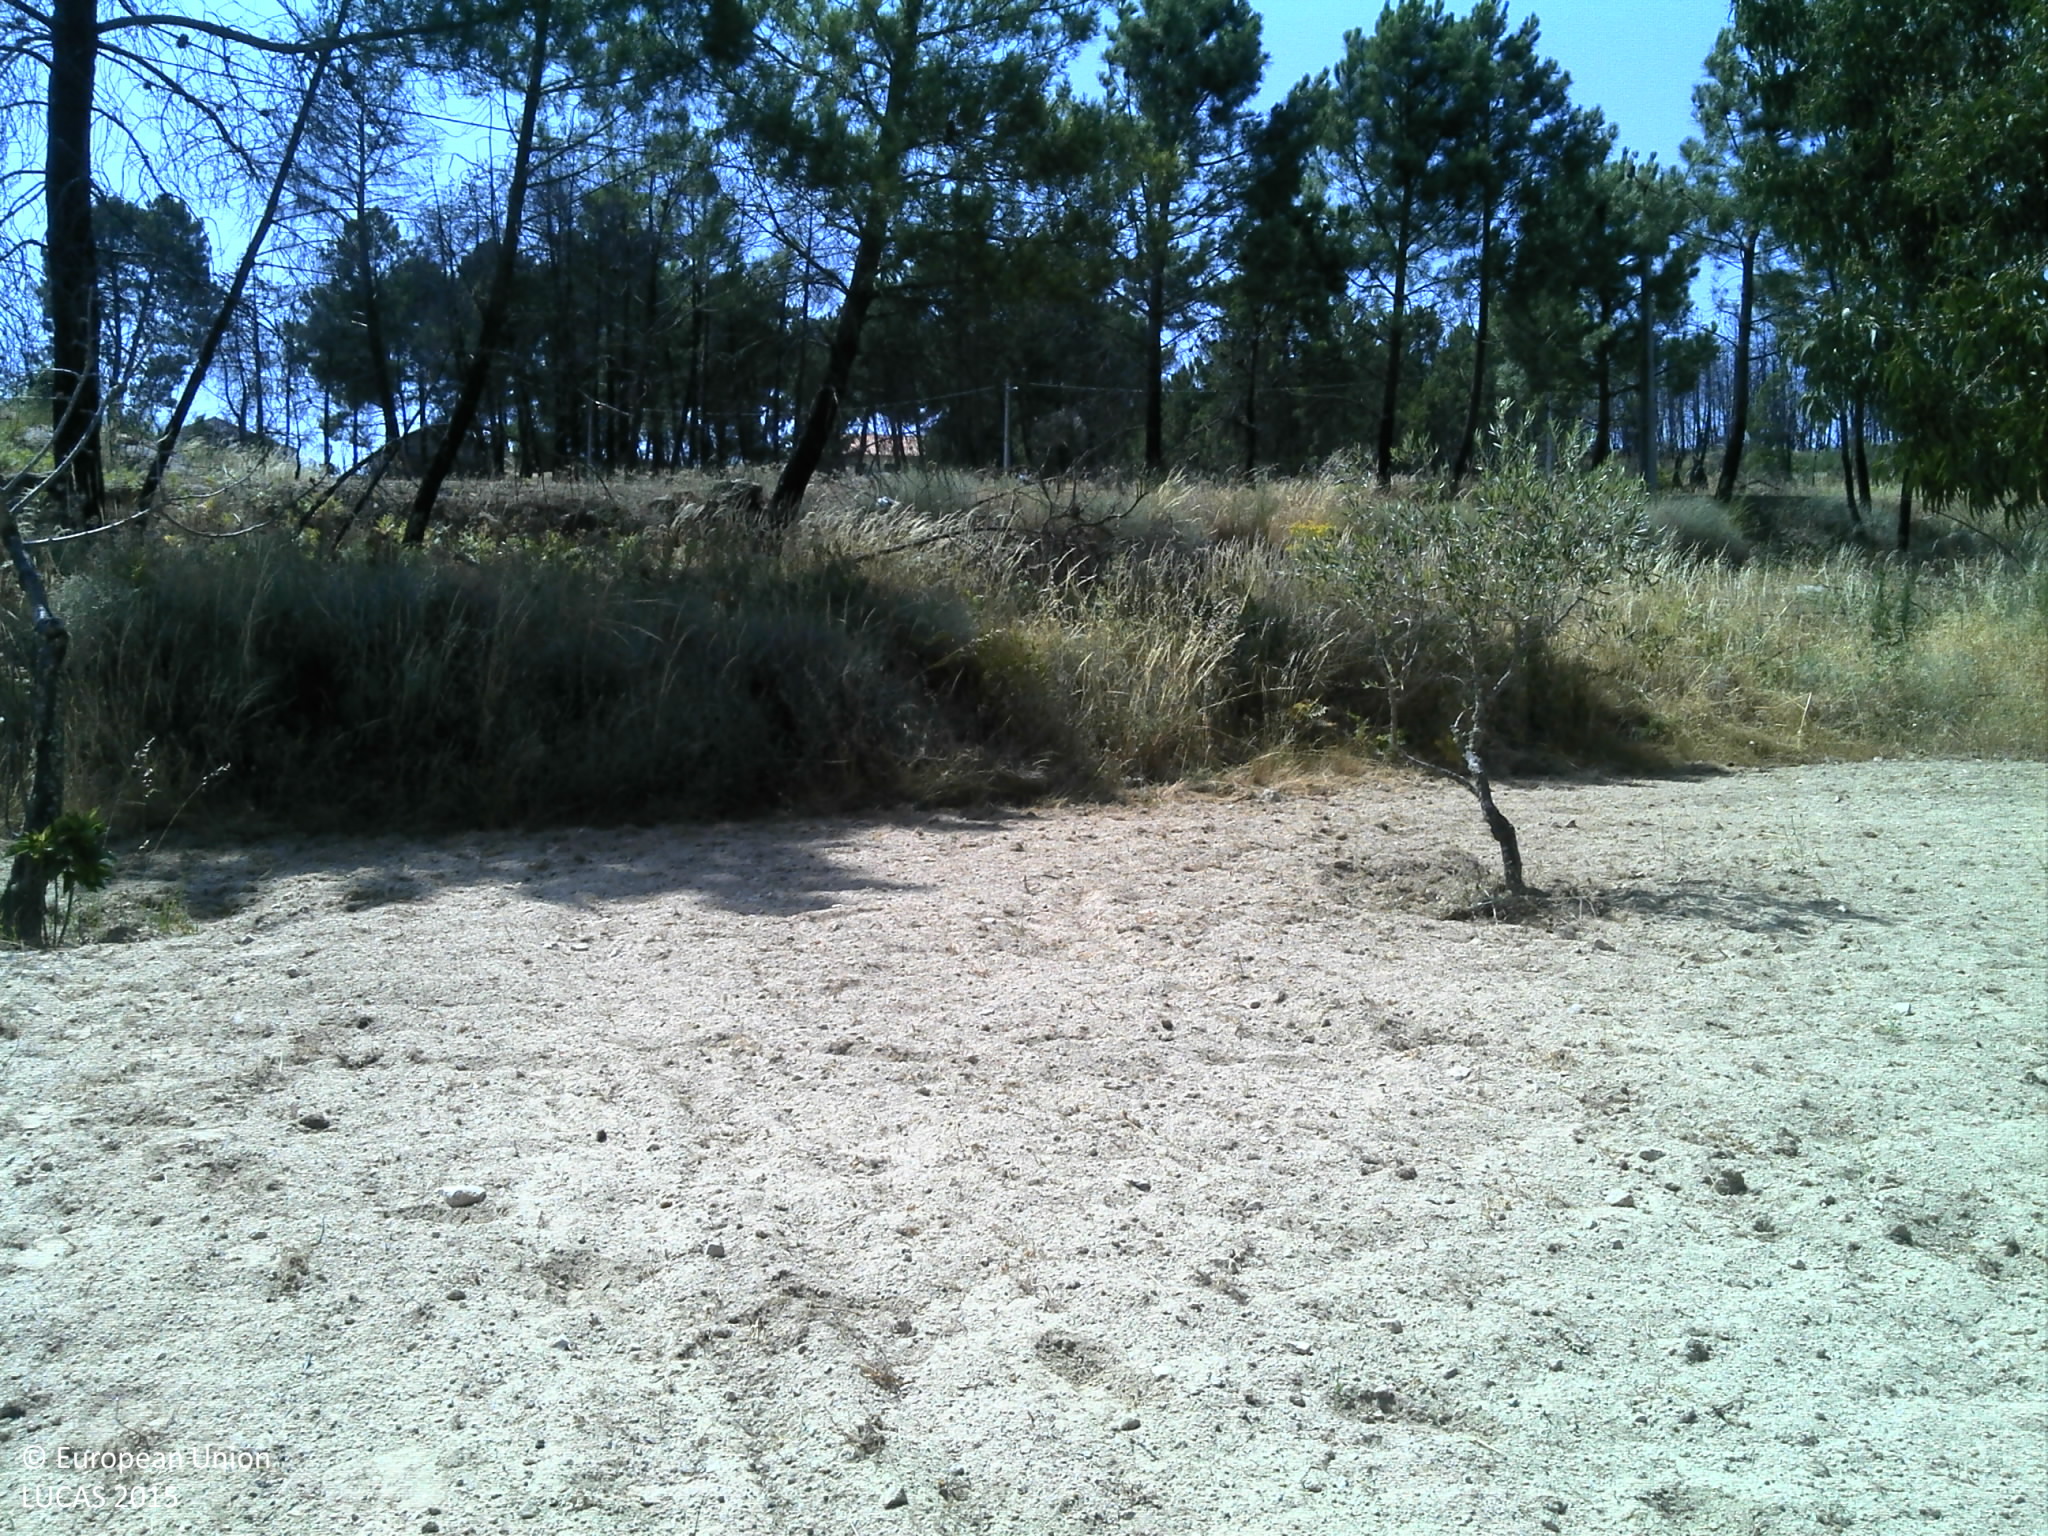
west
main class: Cropland
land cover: Olive groves
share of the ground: 10 - 25 %
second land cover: Other bare soil
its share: > 75 %
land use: Agriculture (excluding fallow land and kitchen gardens)
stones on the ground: 10 - 25 %
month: July
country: PT
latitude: 40.8176
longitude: -7.3145
